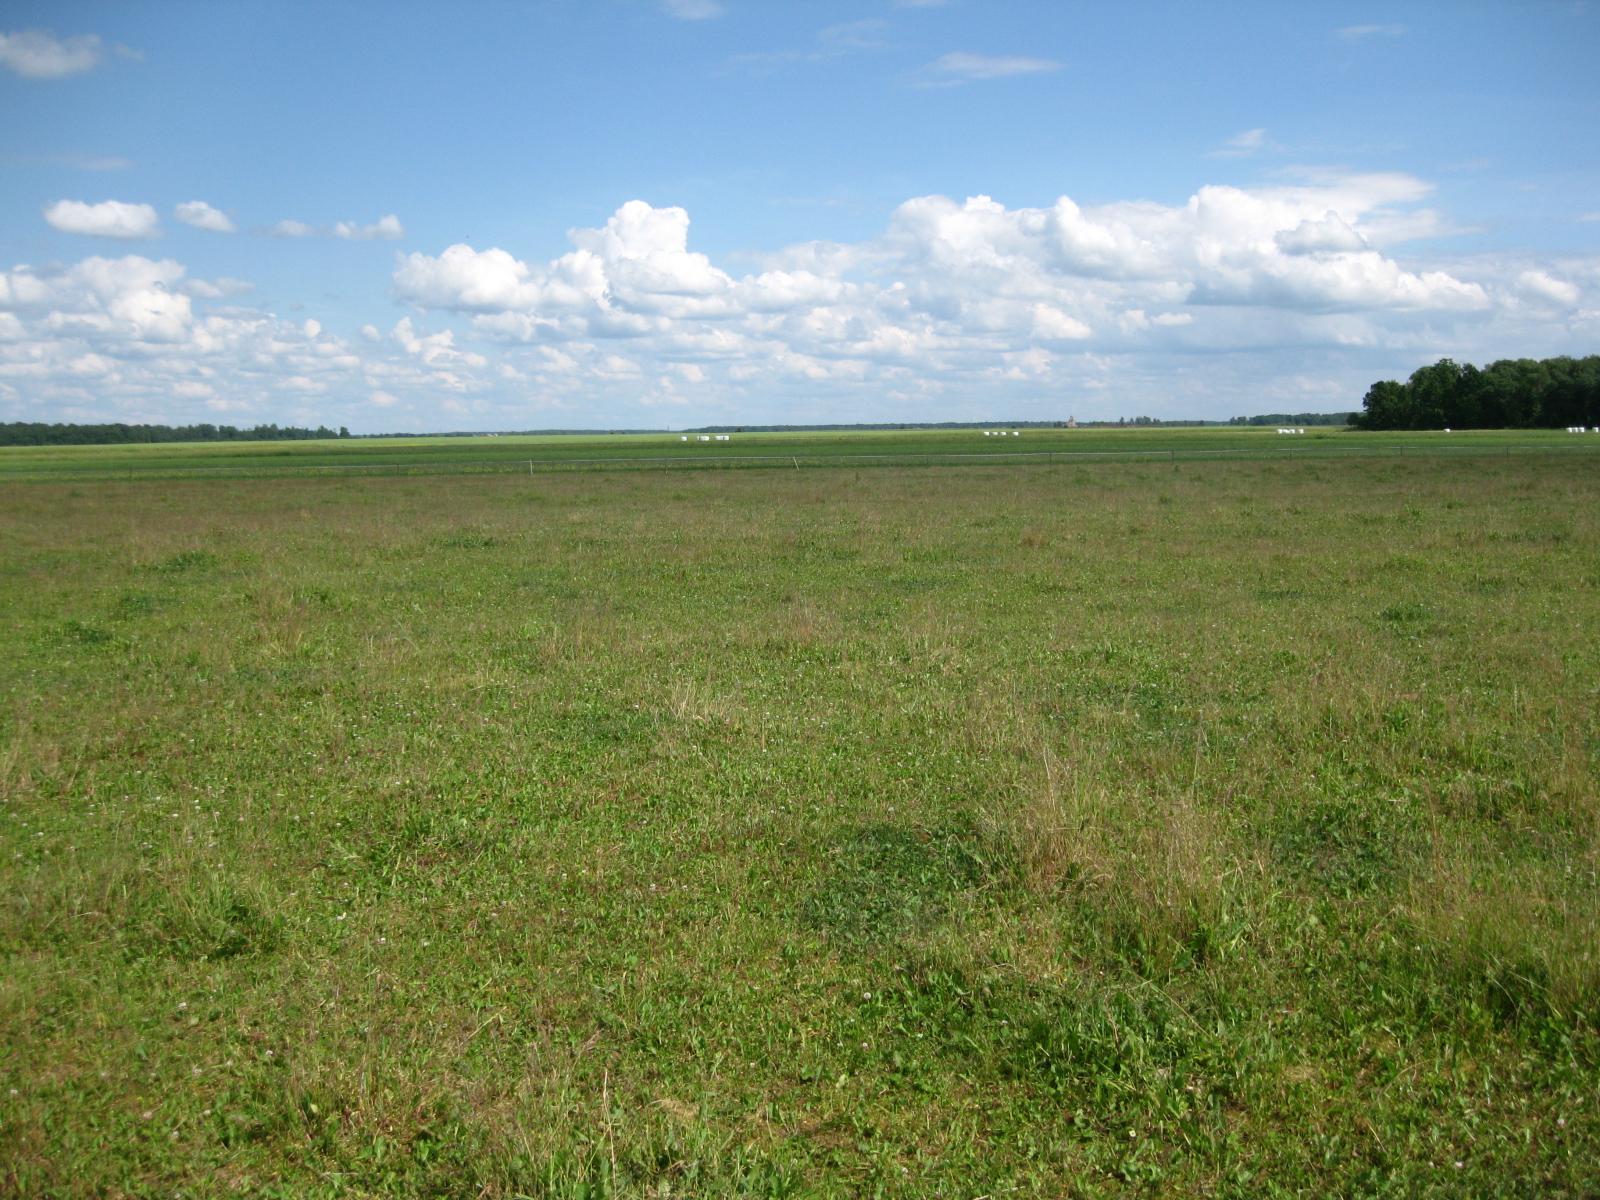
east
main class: Grassland
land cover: Grassland without tree/shrub cover
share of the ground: > 75 %
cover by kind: herbaceous plants 100 %
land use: Agriculture (excluding fallow land and kitchen gardens)
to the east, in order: Grassland without tree/shrub cover; Fences; Grassland without tree/shrub cover
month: June
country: LT
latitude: 55.3194
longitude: 24.0369
